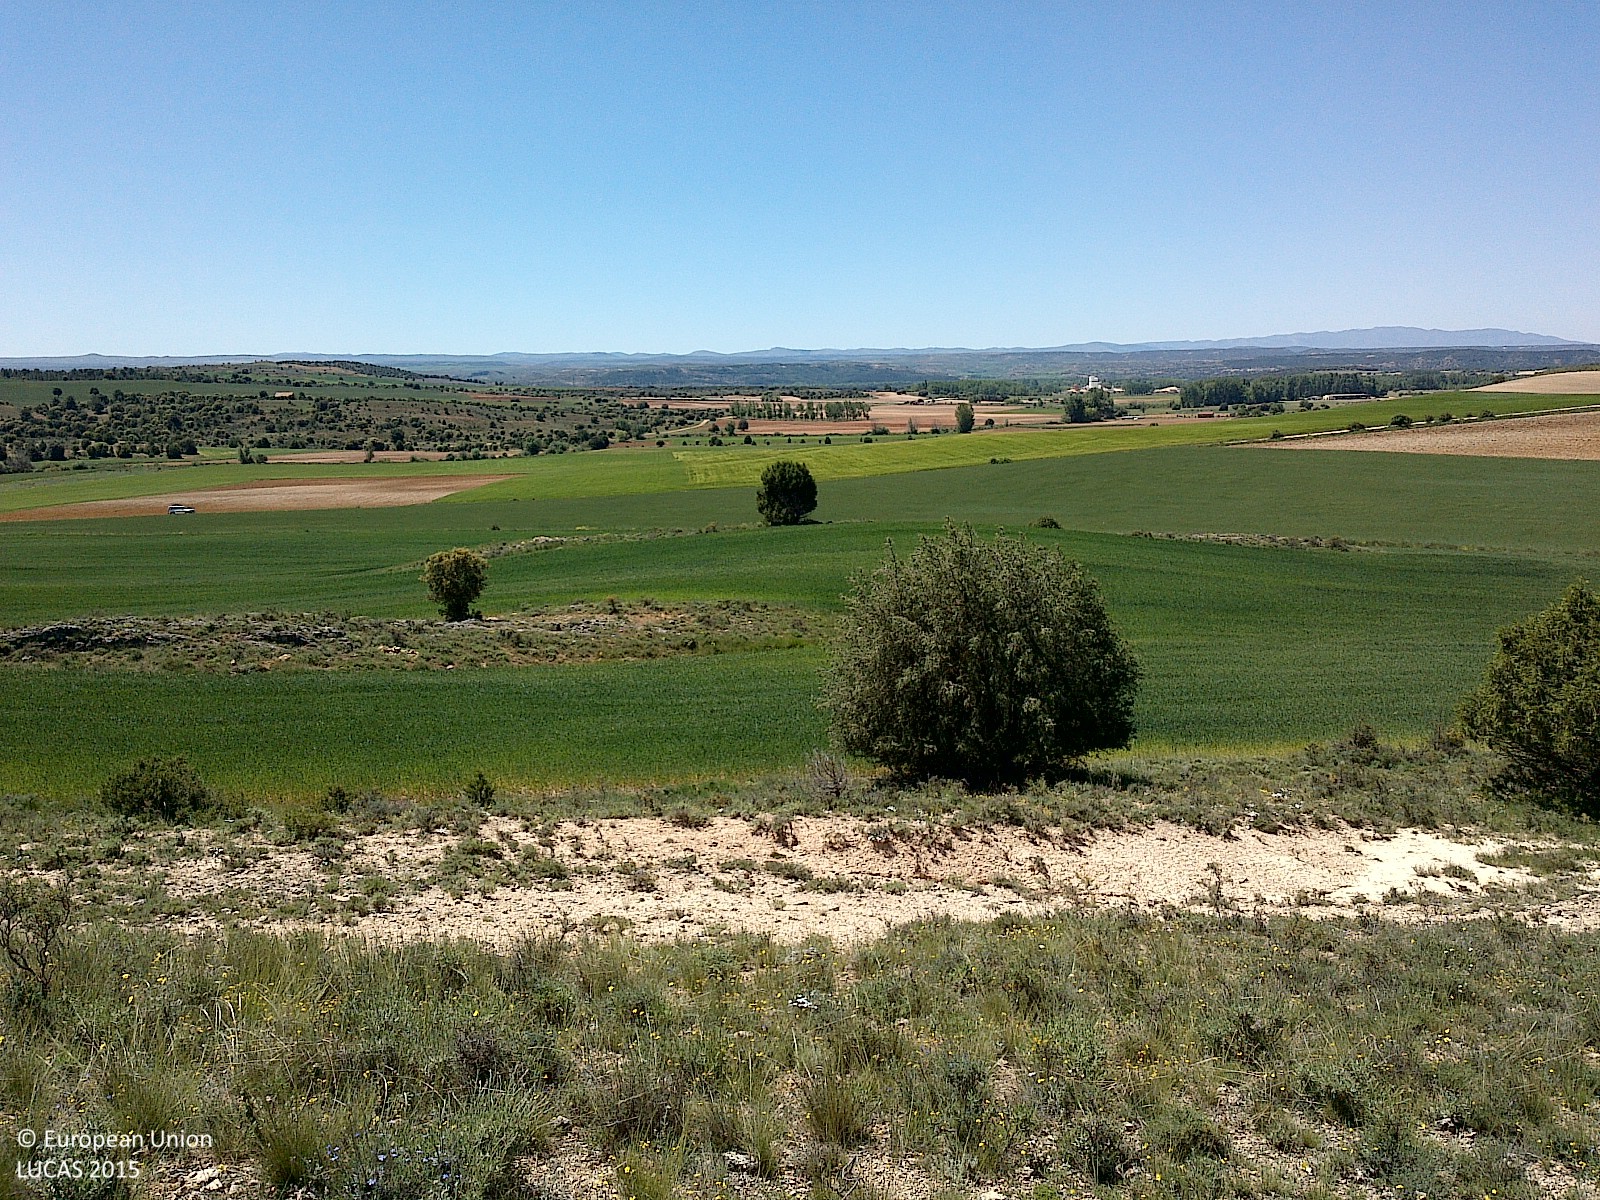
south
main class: Shrubland
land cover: Shrubland without tree cover
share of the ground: 50 - 75 %
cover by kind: shrubs 55 %, consolidated bare surface 35 %, herbaceous plants 10 %
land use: Semi-natural and natural areas not in use
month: May
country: ES
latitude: 41.5676
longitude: -3.0542
